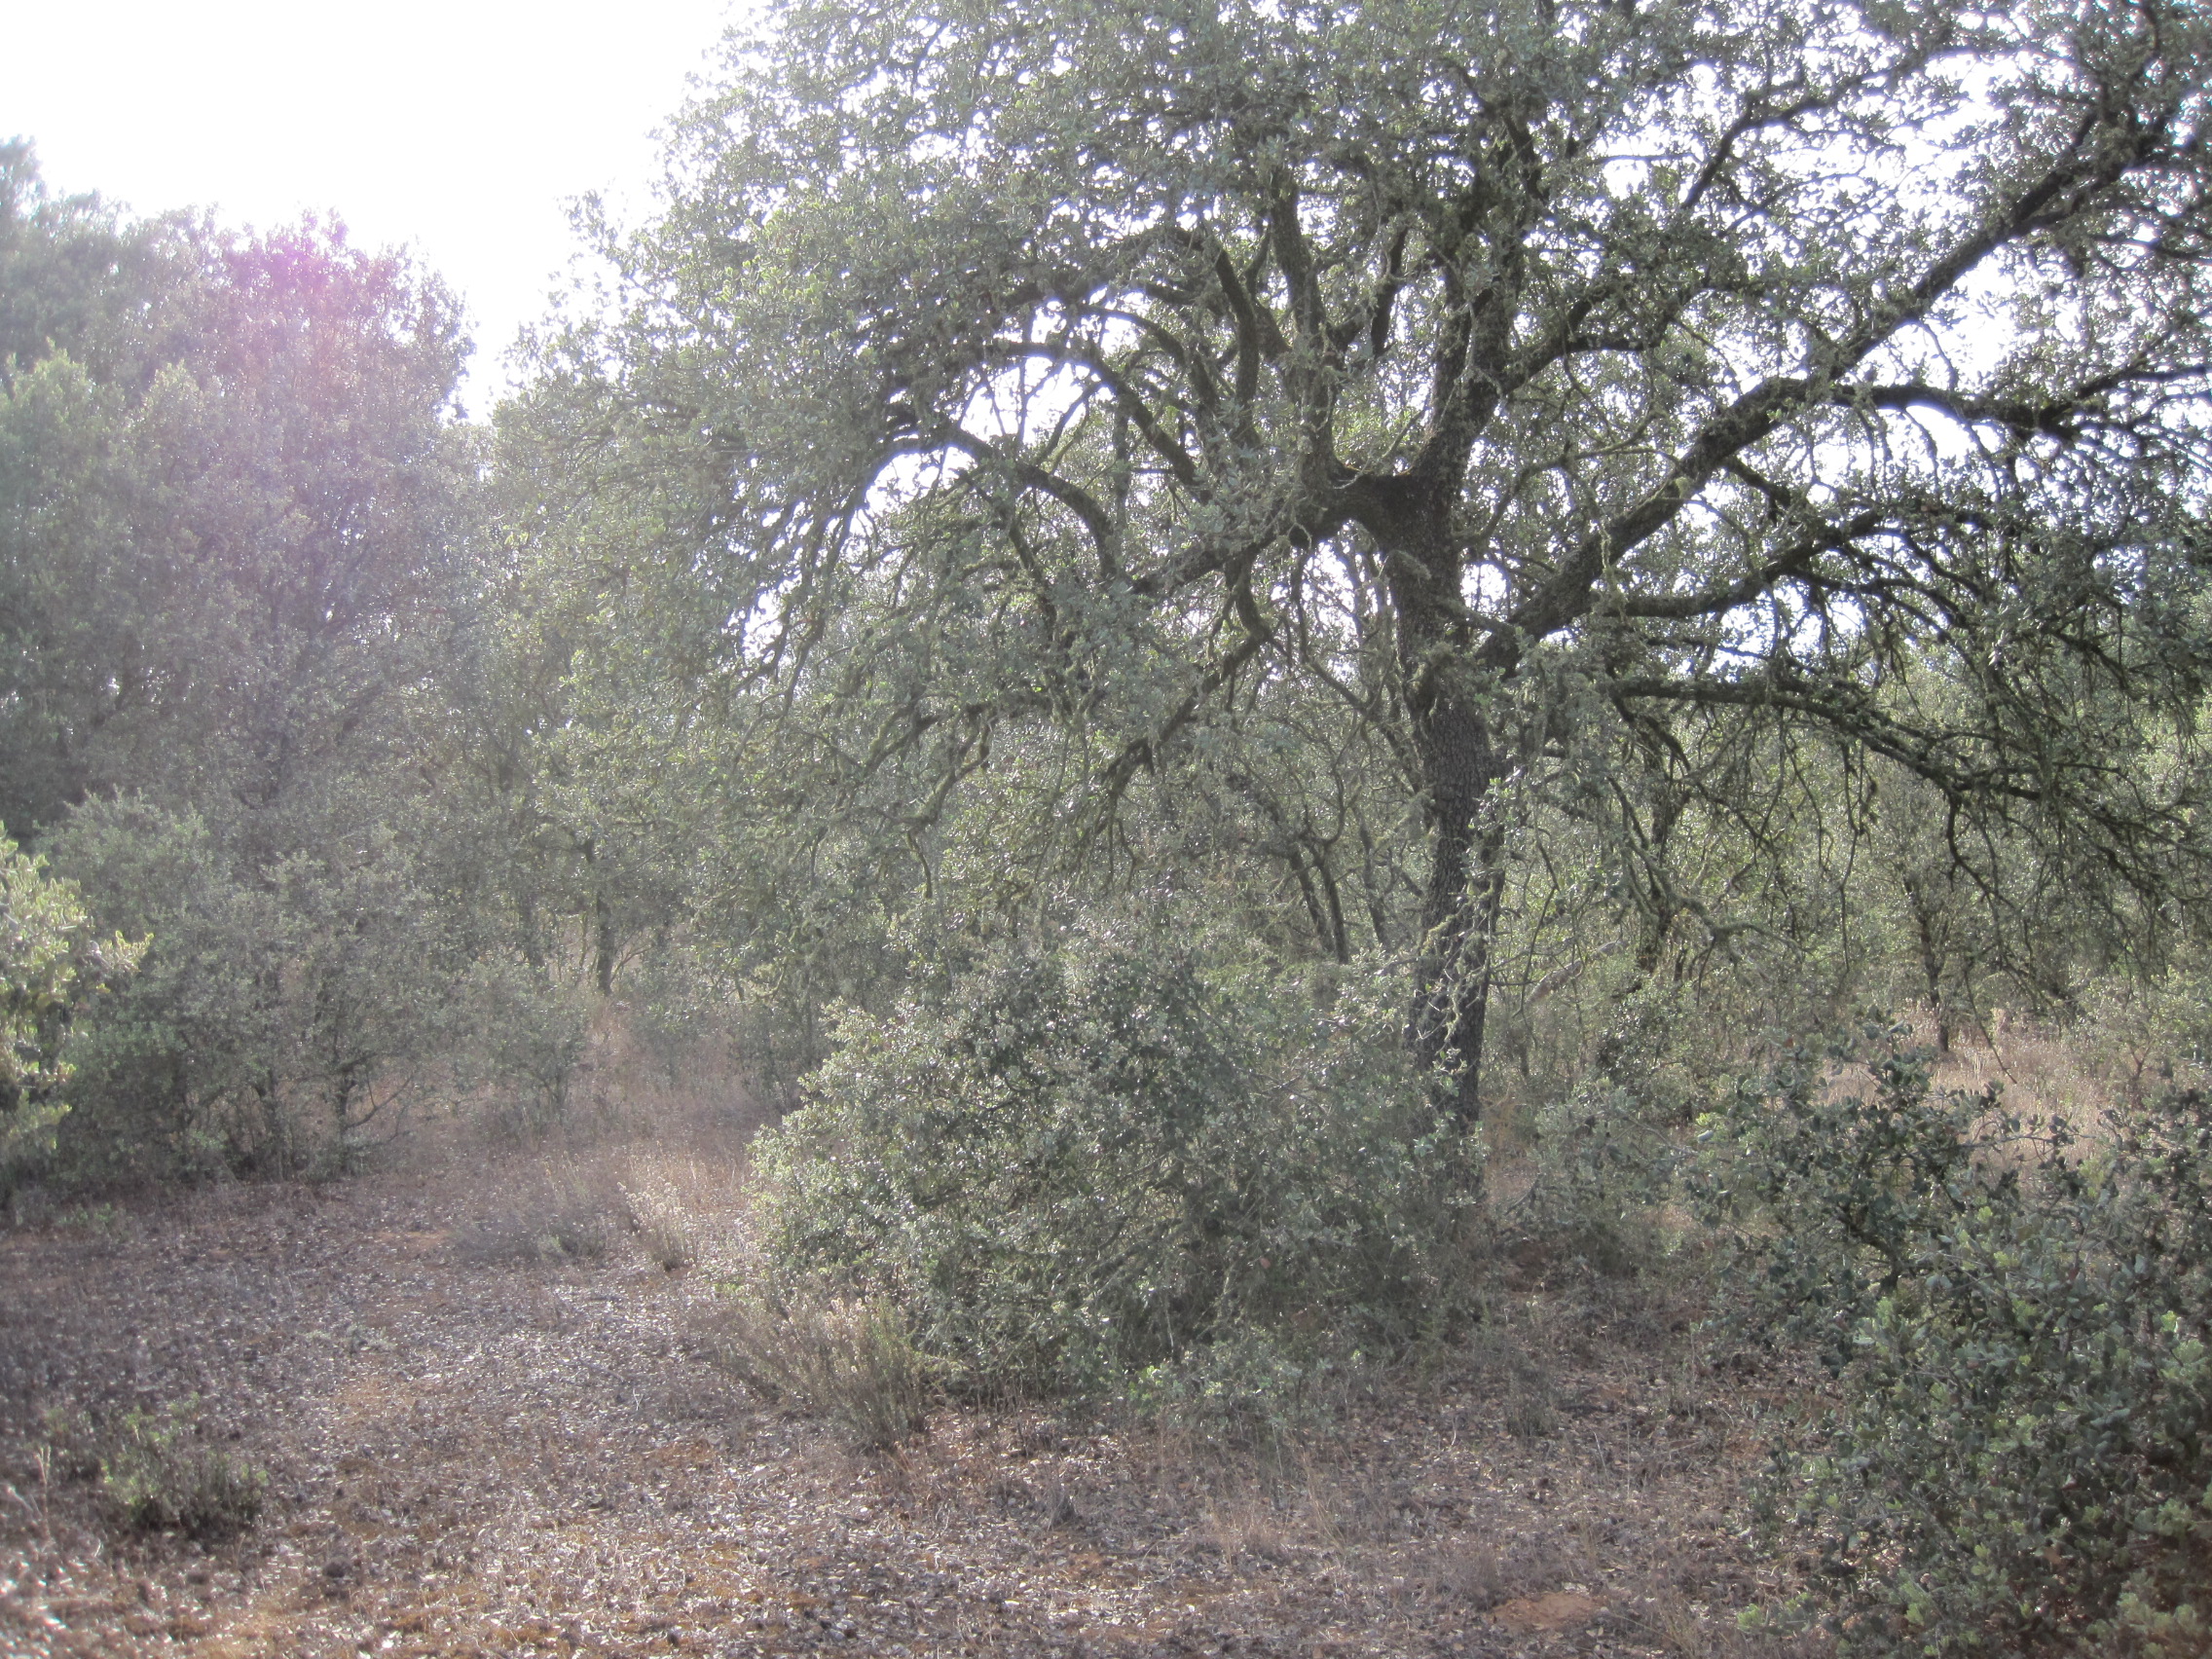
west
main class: Woodland
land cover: Broadleaved woodland
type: broadleaved evergreen forest
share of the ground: 50 - 75 %
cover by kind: broadleaved forest trees 70 %, herbaceous plants 30 %
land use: Forestry
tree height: > 5 m
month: July
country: ES
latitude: 41.9270
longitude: -5.6340
